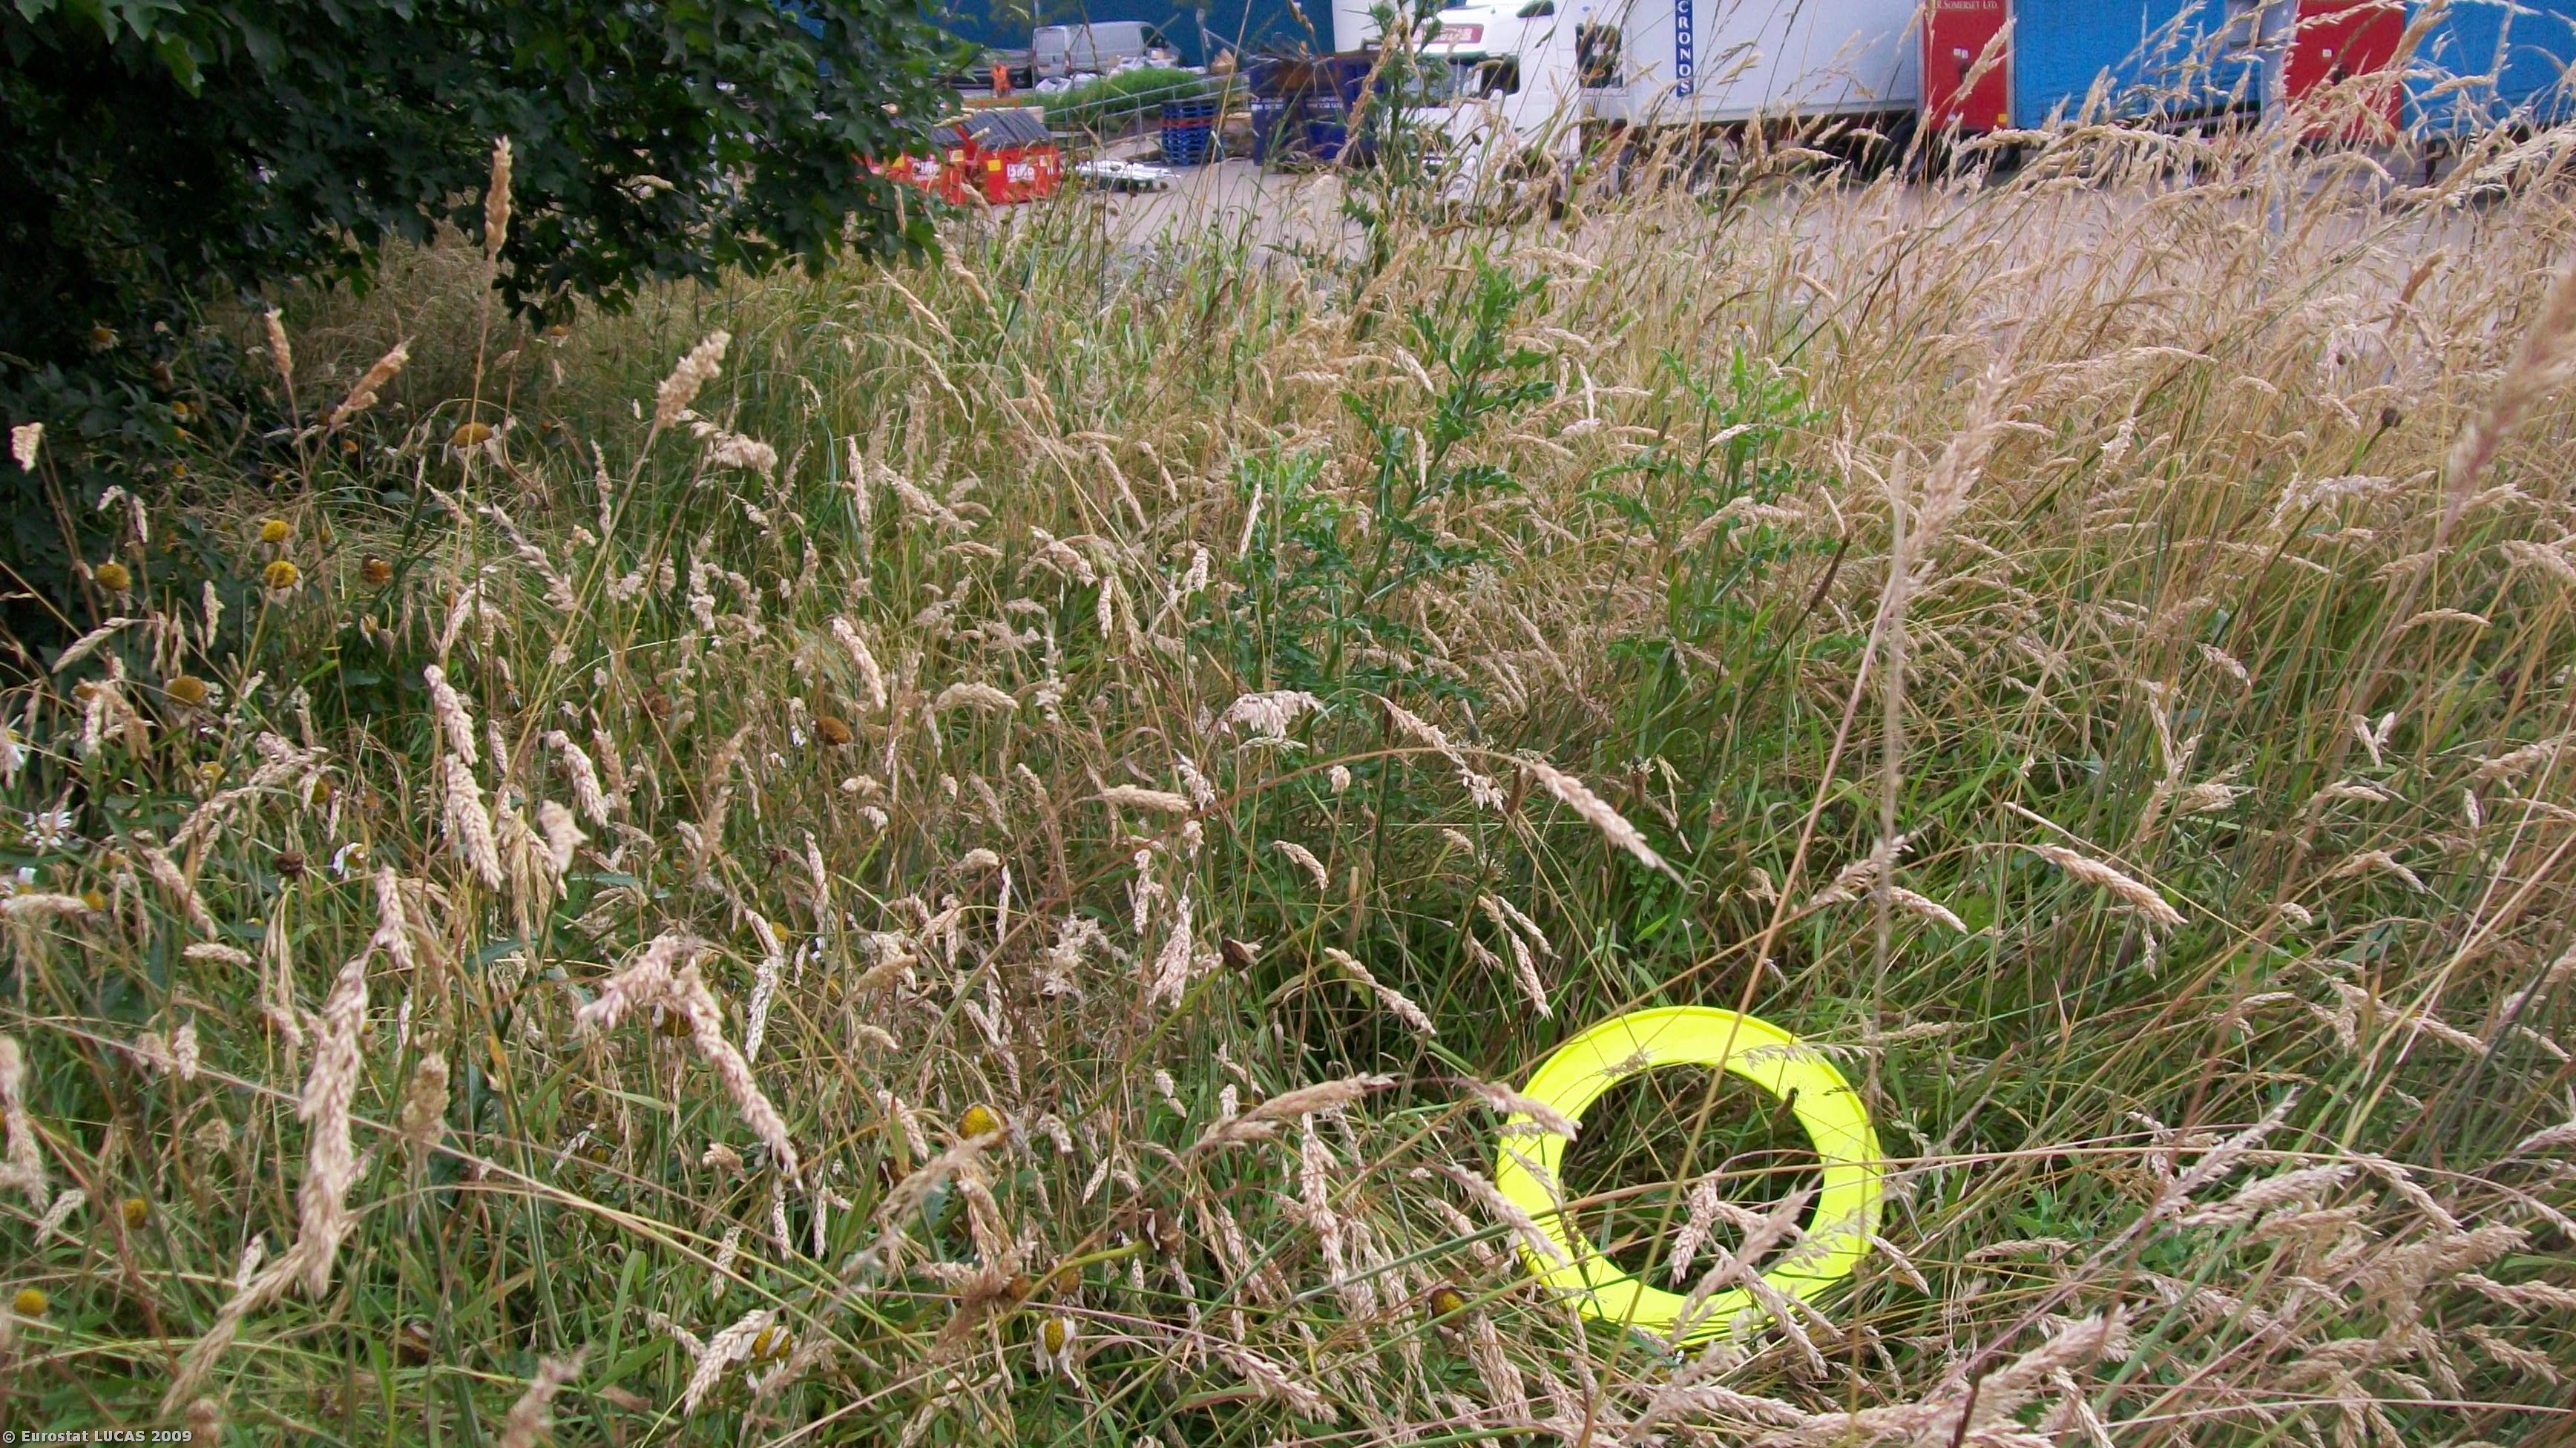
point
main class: Grassland
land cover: Grassland with sparse tree/shrub cover
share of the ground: > 75 %
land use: Unused
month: July
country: GB
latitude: 52.7038
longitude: -1.3405
